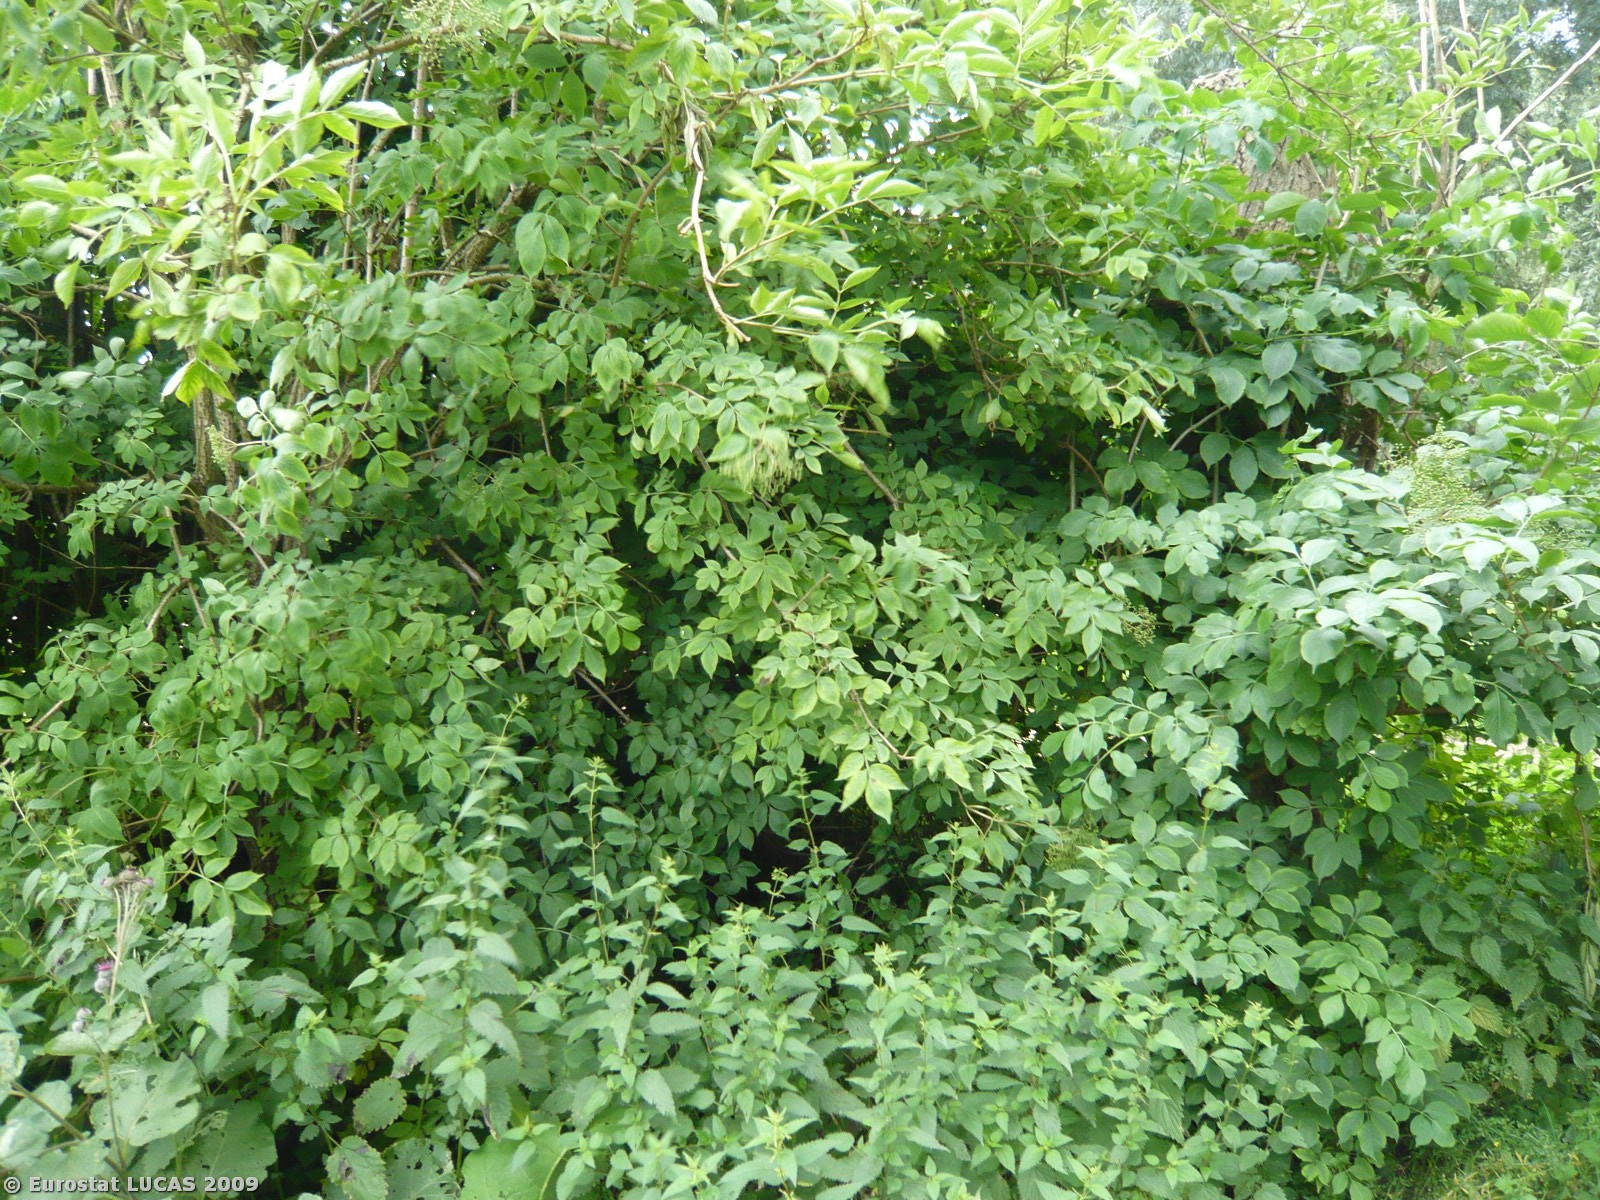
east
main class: Woodland
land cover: Broadleaved woodland
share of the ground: > 75 %
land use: Unused
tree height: < 5 m
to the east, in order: Broadleaved woodland; Spontaneously vegetated surfaces; Ditches and canals; Broadleaved woodland; Tracks; Broadleaved woodland; Artificial constructions in urban areas; Fences; Grassland without tree/shrub cover; Fences; Grassland without tree/shrub cover; Broadleaved woodland
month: July
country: DK
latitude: 55.4862
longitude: 12.1663
